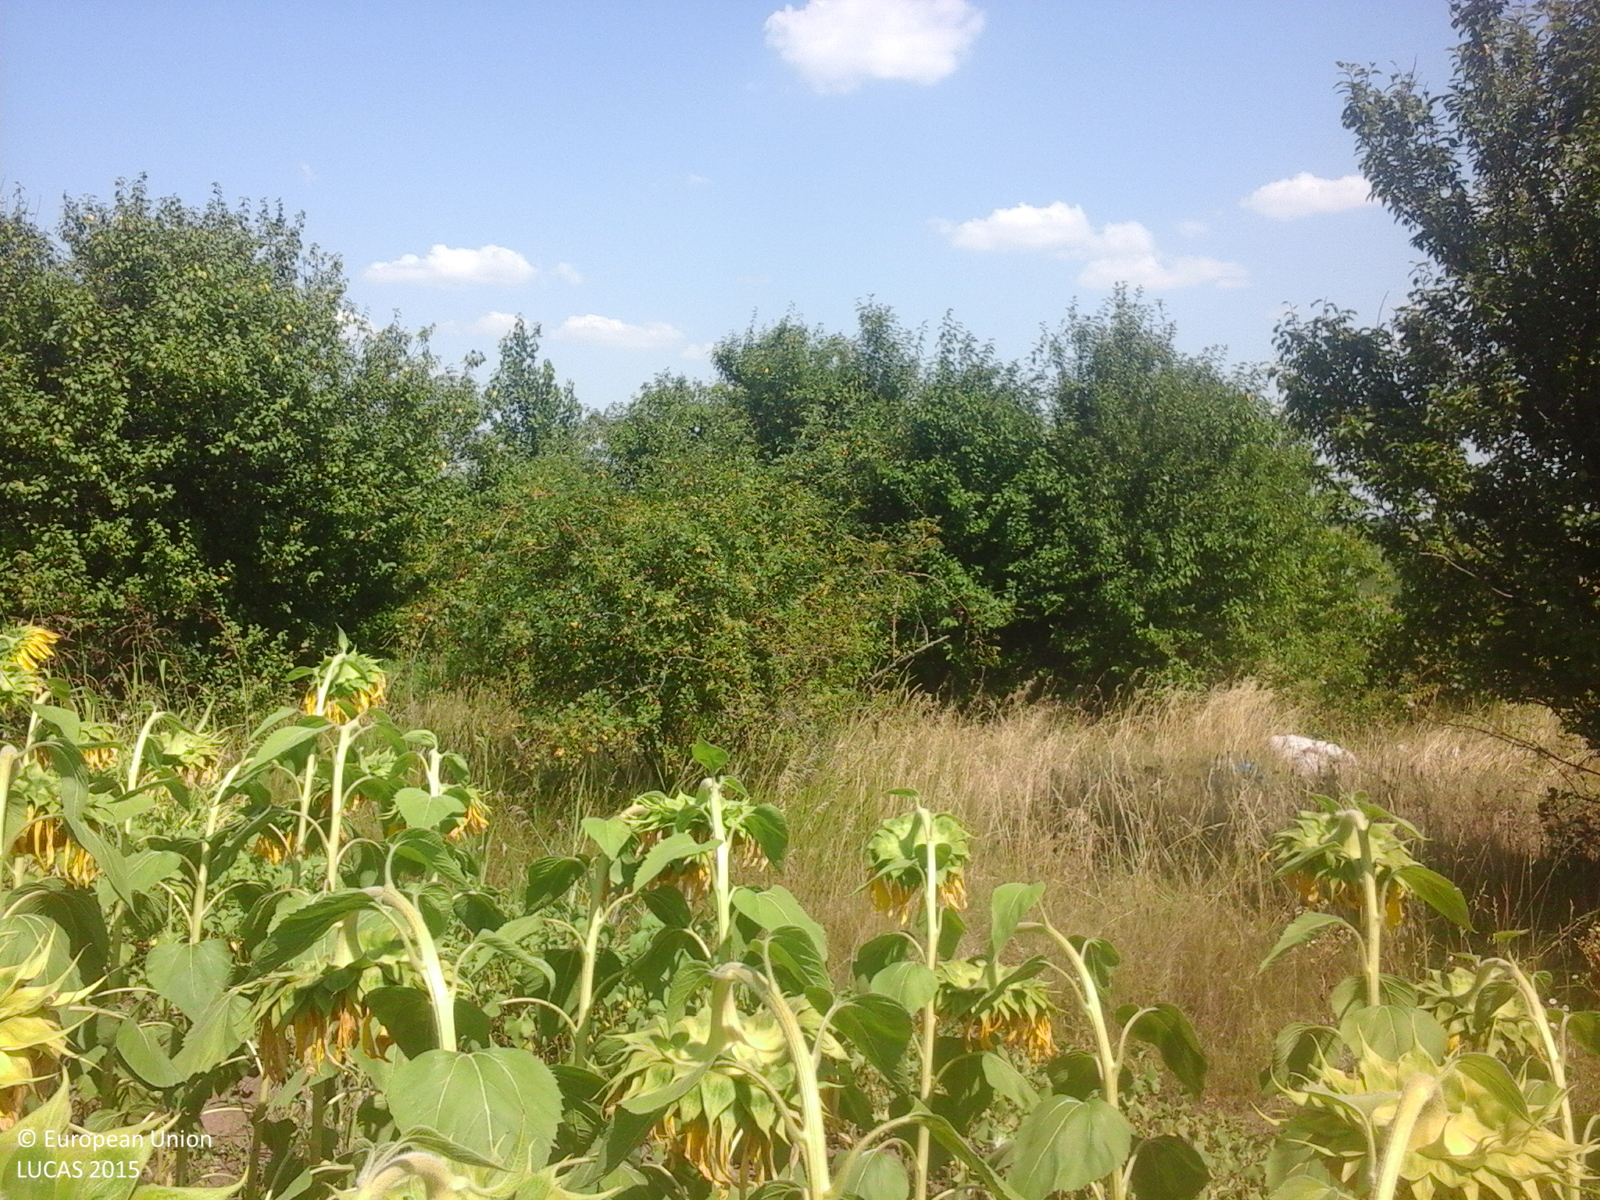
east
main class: Cropland
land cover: Sunflower
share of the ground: > 75 %
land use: Agriculture (excluding fallow land and kitchen gardens)
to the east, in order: Sunflower; Grass margins; Abandoned hedges; Tracks; Single bushes/trees; Spontaneously vegetated surfaces; Ditches and canals; Spontaneously vegetated surfaces; Lucerne
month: July
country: RO
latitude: 45.0080
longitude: 26.8133
